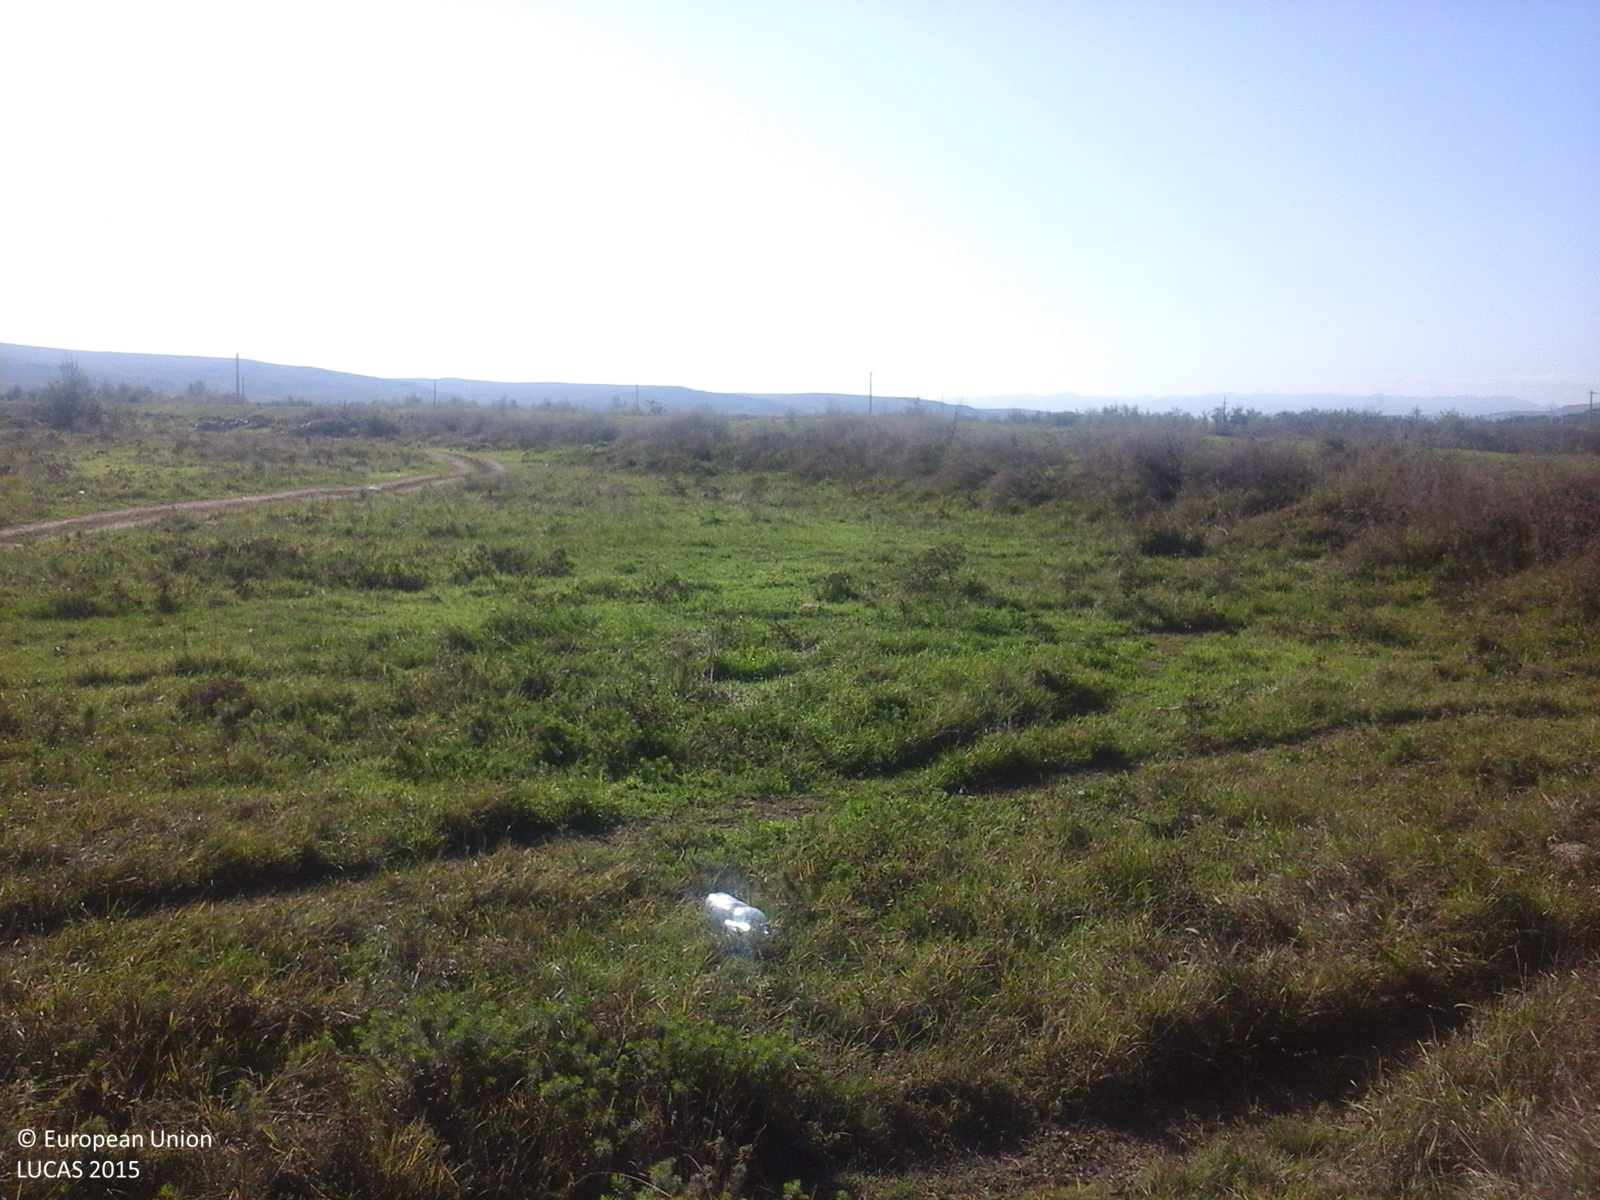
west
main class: Grassland
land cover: Grassland without tree/shrub cover
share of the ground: > 75 %
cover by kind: herbaceous plants 100 %
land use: Agriculture (excluding fallow land and kitchen gardens)
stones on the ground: < 10 %
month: October
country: RO
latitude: 46.1699
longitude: 23.8926
